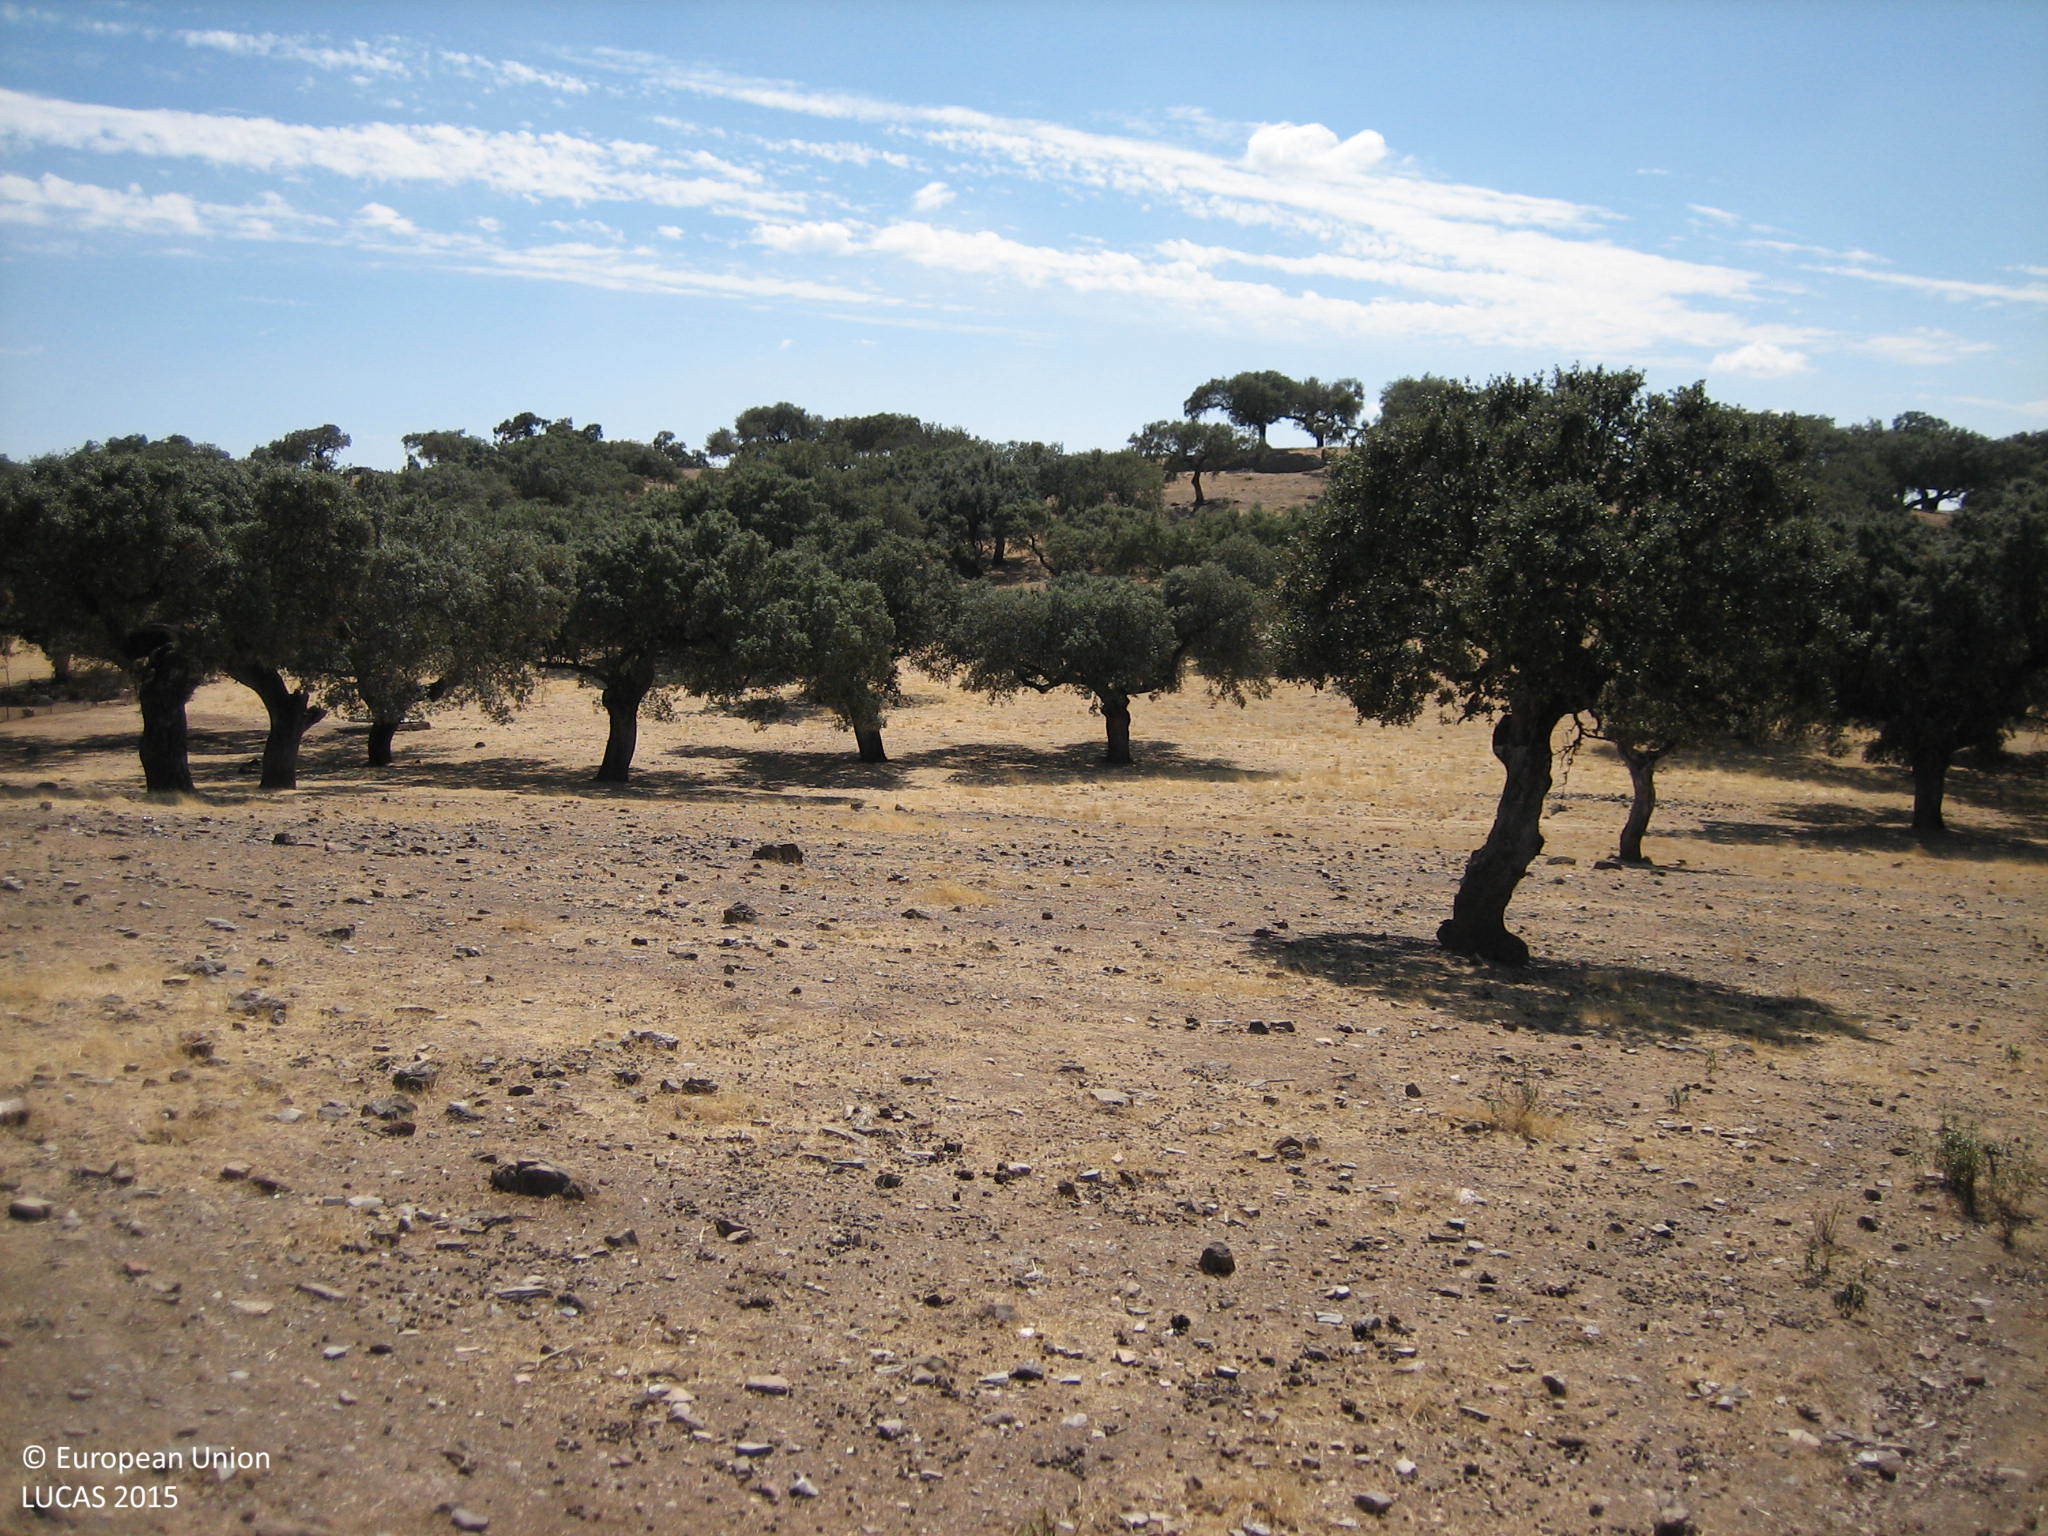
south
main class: Woodland
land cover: Broadleaved woodland
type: broadleaved evergreen forest
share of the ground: 10 - 25 %
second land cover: Grassland without tree/shrub cover
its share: 50 - 75 %
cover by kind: herbaceous plants 50 %, unconsolidated bare surface 25 %, broadleaved forest trees 20 %, shrubs 5 %
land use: Forestry
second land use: Agriculture (excluding fallow land and kitchen gardens)
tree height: > 5 m
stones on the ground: < 10 %
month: September
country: ES
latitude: 38.2023
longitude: -7.0861
